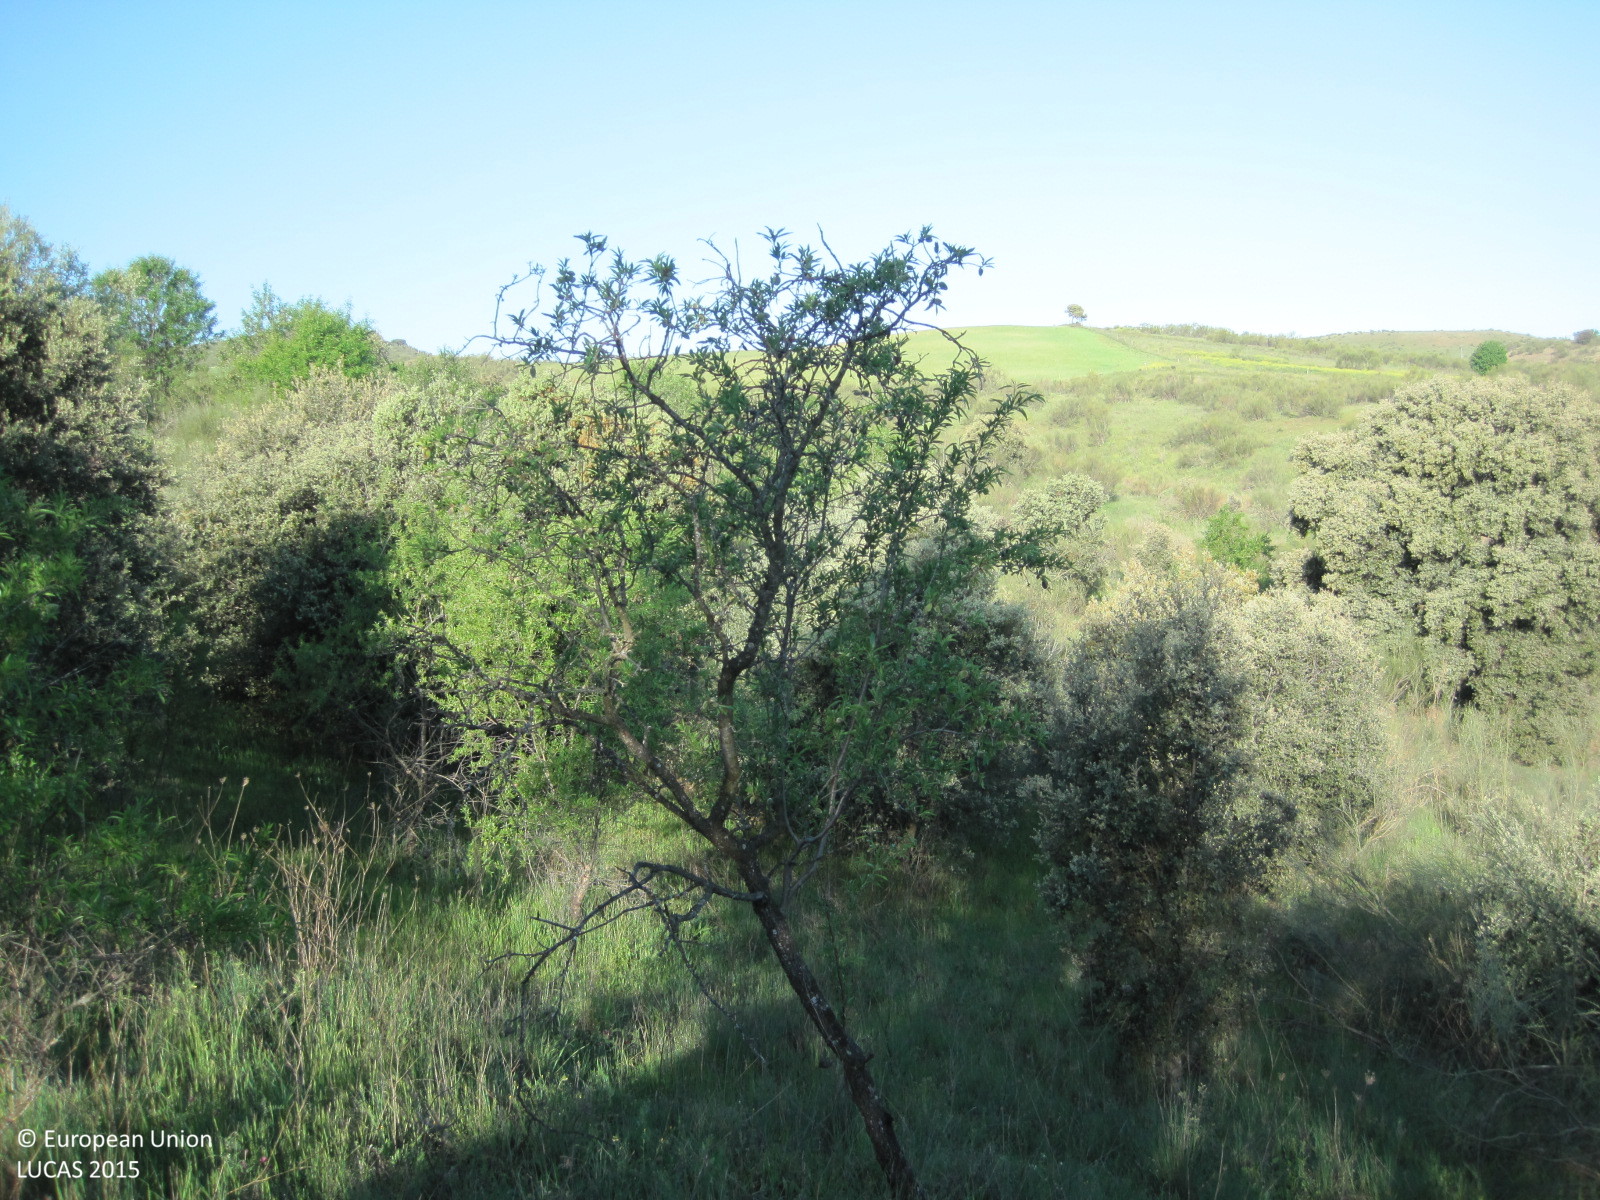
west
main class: Woodland
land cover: Broadleaved woodland
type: thermophilous deciduous forest
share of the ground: 10 - 25 %
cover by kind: herbaceous plants 50 %, shrubs 35 %, broadleaved forest trees 15 %
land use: Agriculture (excluding fallow land and kitchen gardens)
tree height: < 5 m
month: April
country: ES
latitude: 39.8563
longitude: -4.9039
